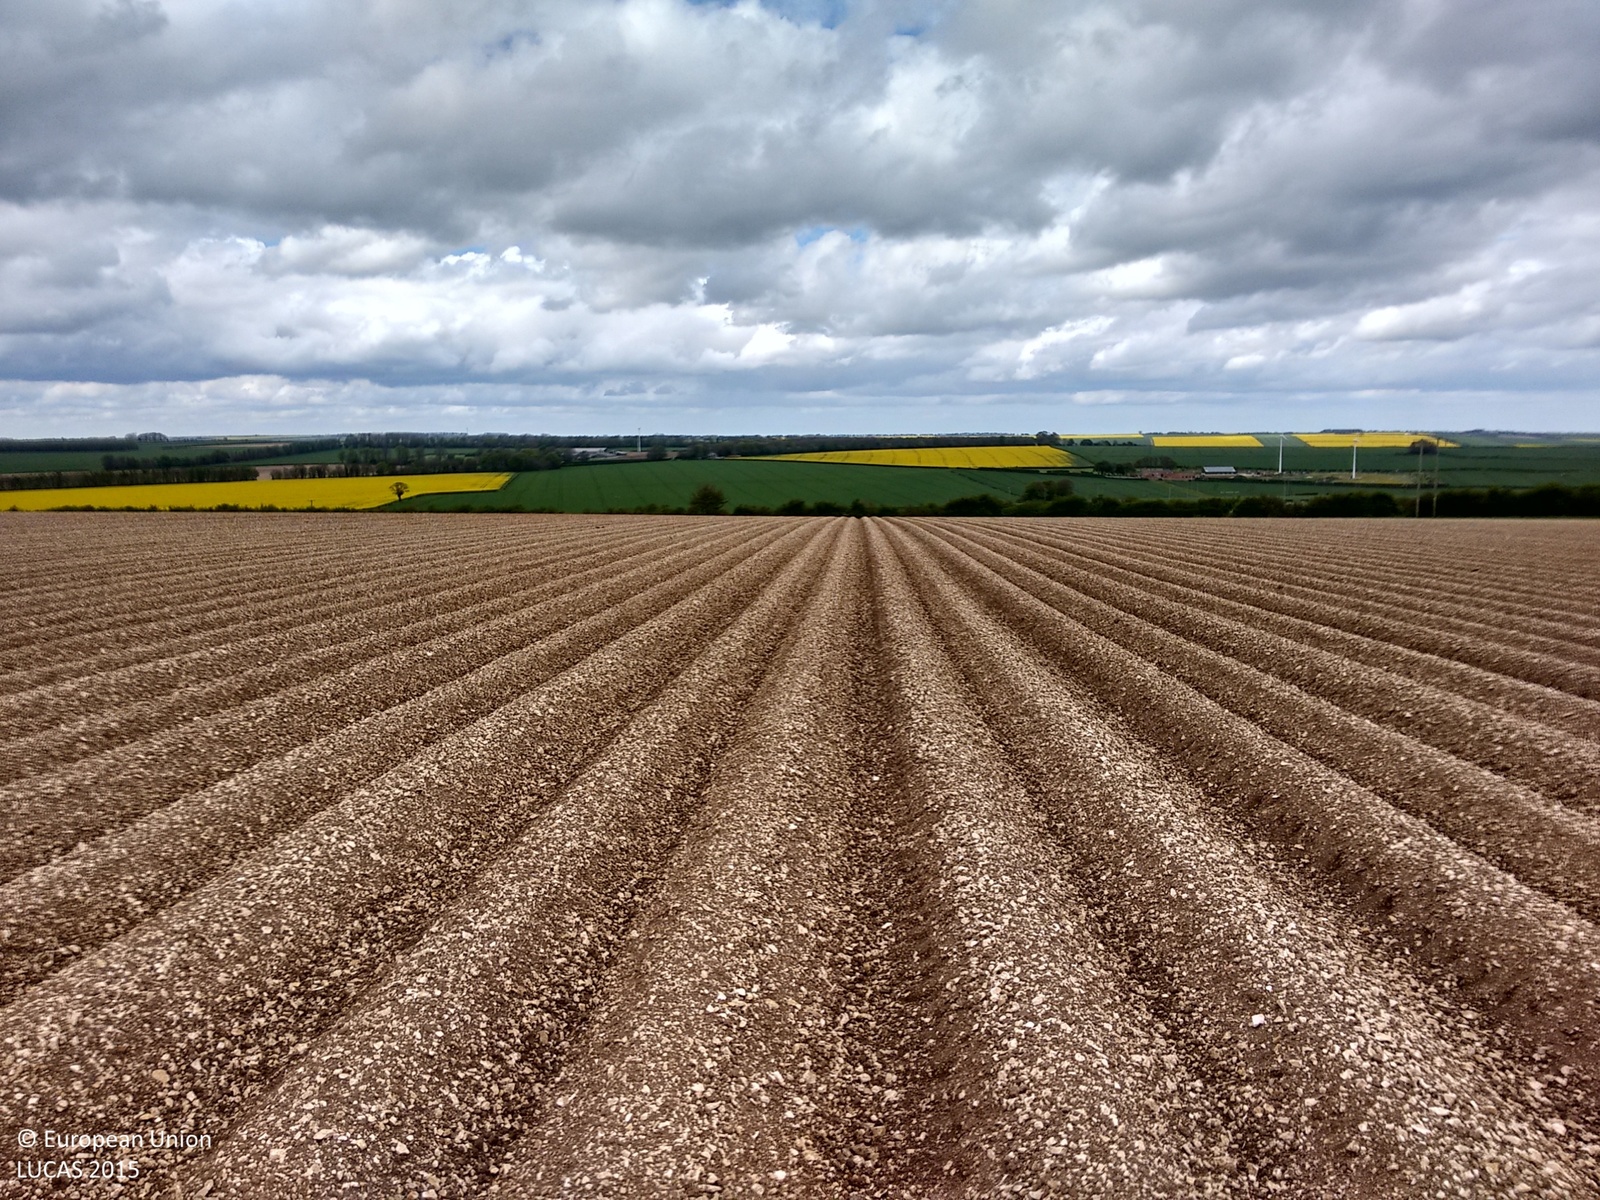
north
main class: Cropland
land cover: Potatoes
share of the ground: < 10 %
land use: Agriculture (excluding fallow land and kitchen gardens)
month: May
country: GB
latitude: 54.0406
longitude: -0.4040
